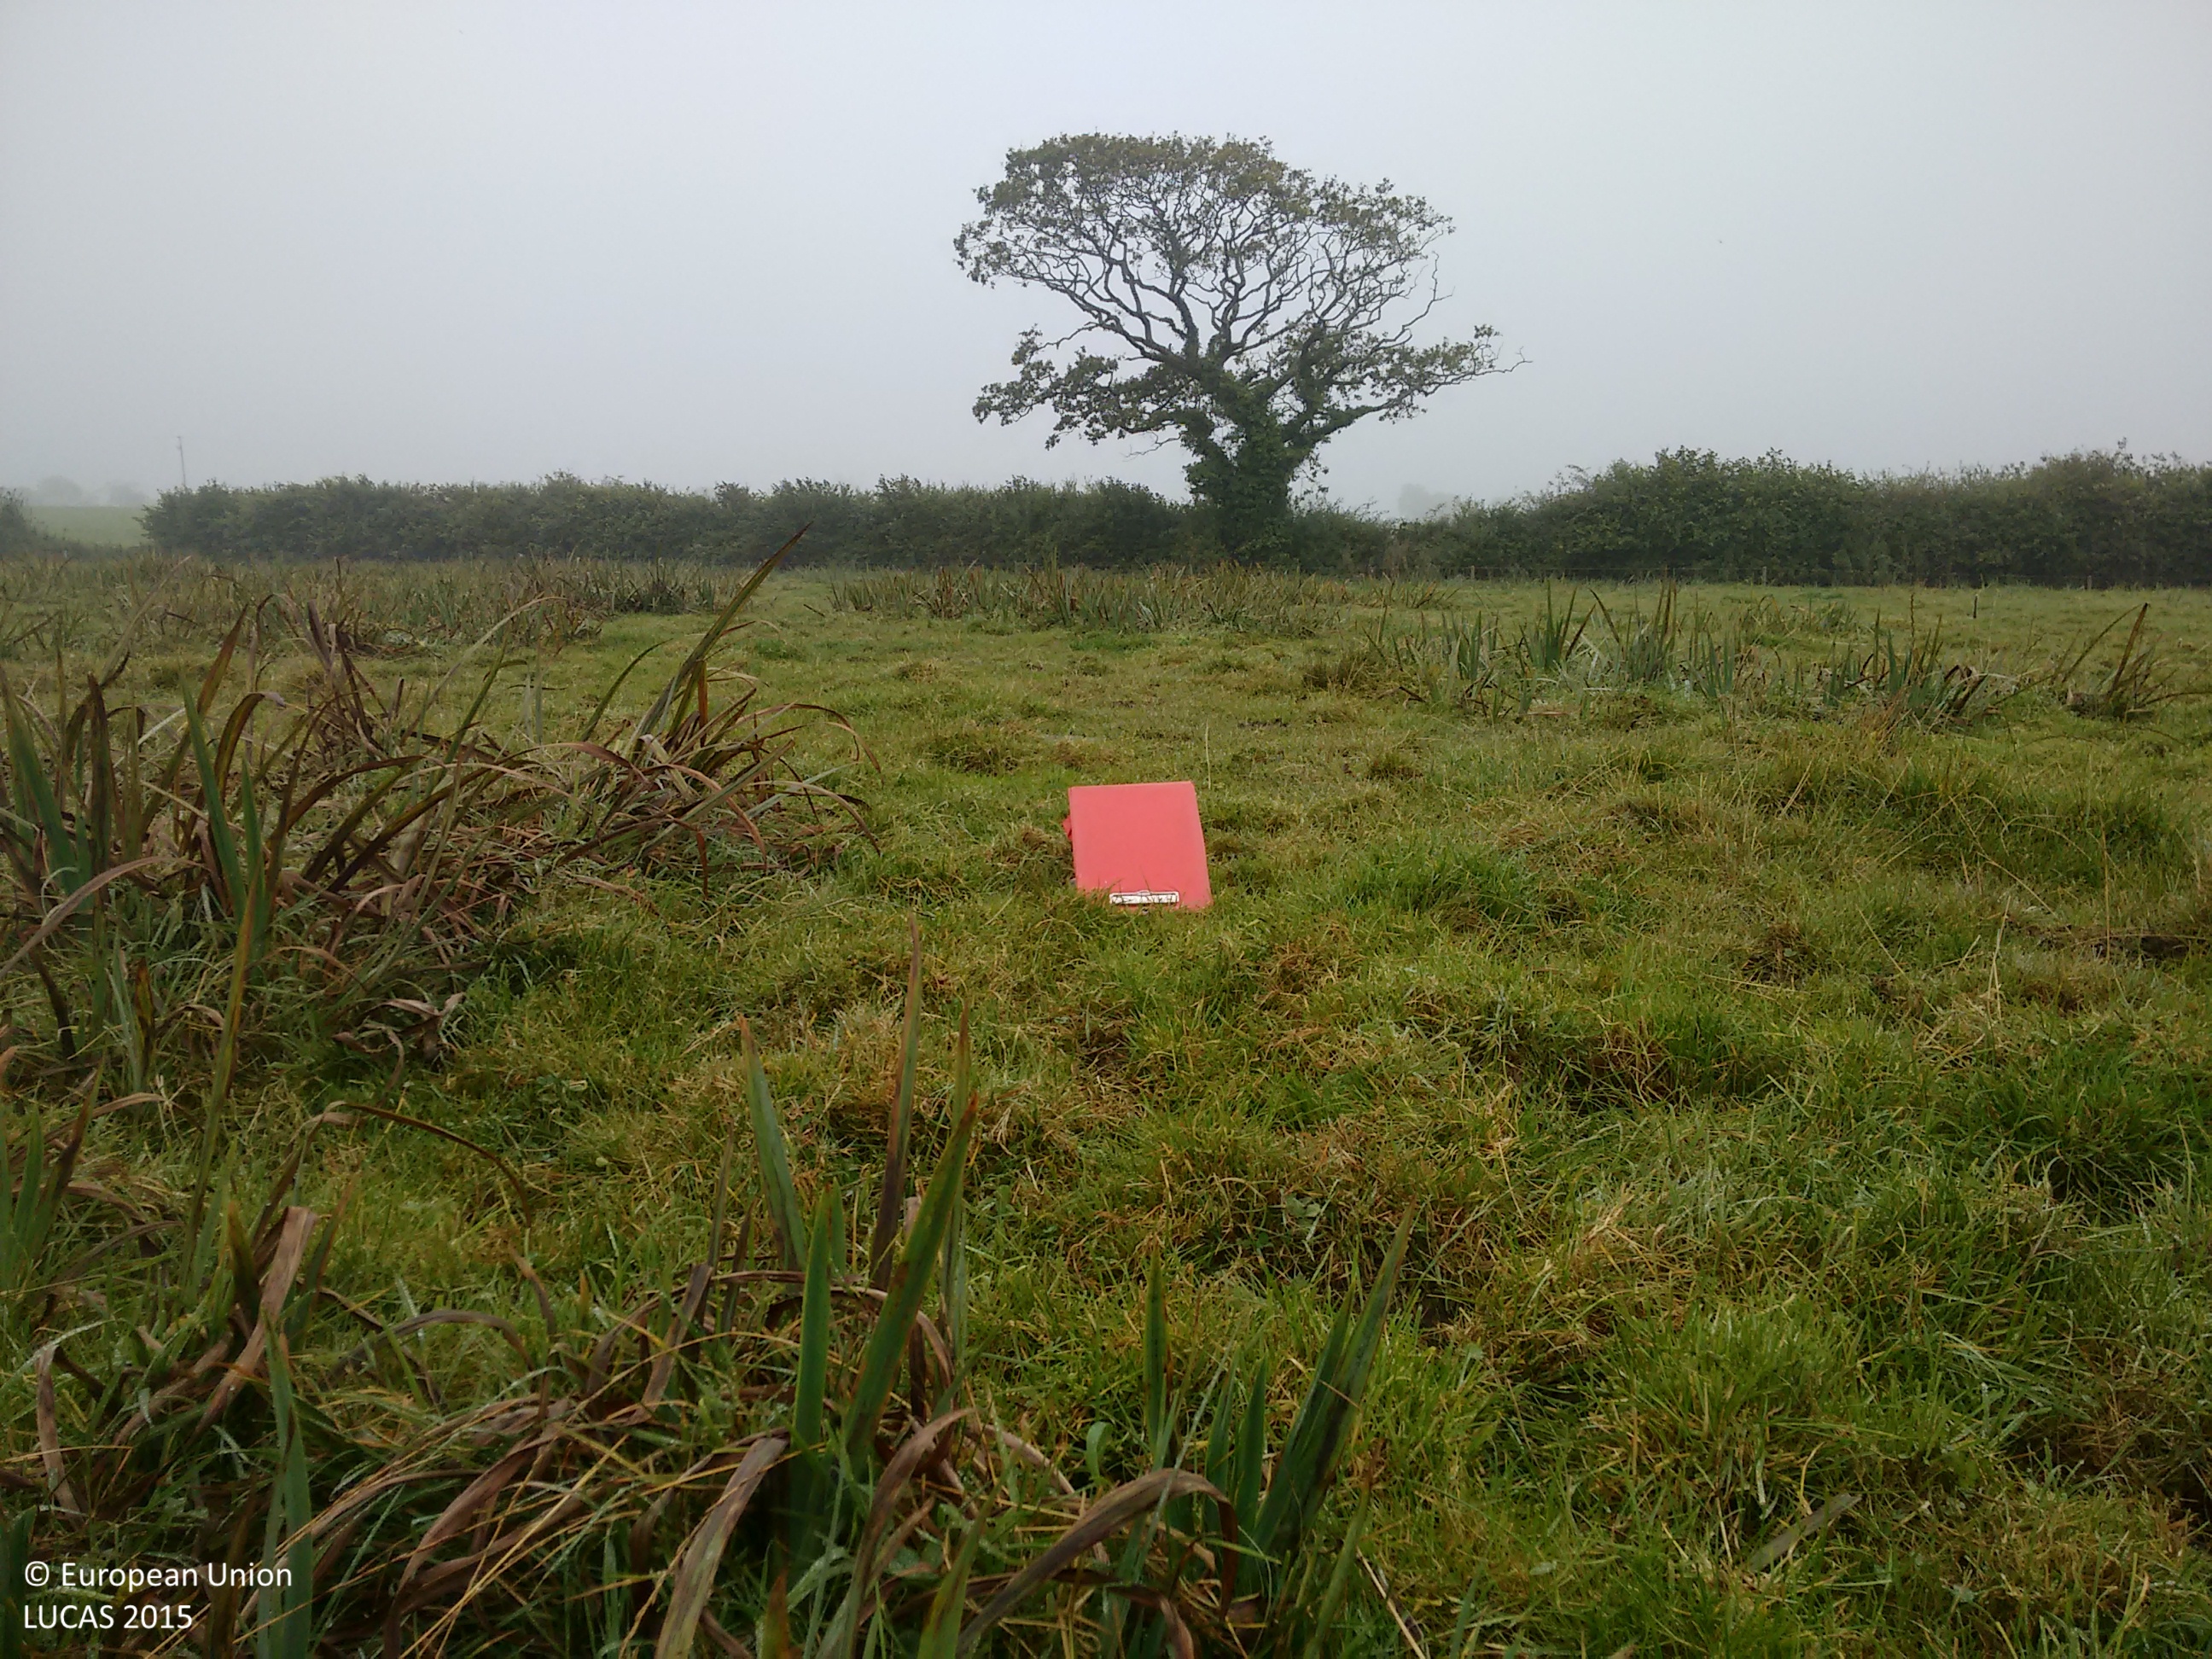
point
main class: Grassland
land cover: Grassland without tree/shrub cover
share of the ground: > 75 %
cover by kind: herbaceous plants 100 %
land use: Agriculture (excluding fallow land and kitchen gardens)
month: October
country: IE
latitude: 52.4667
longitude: -9.0105
